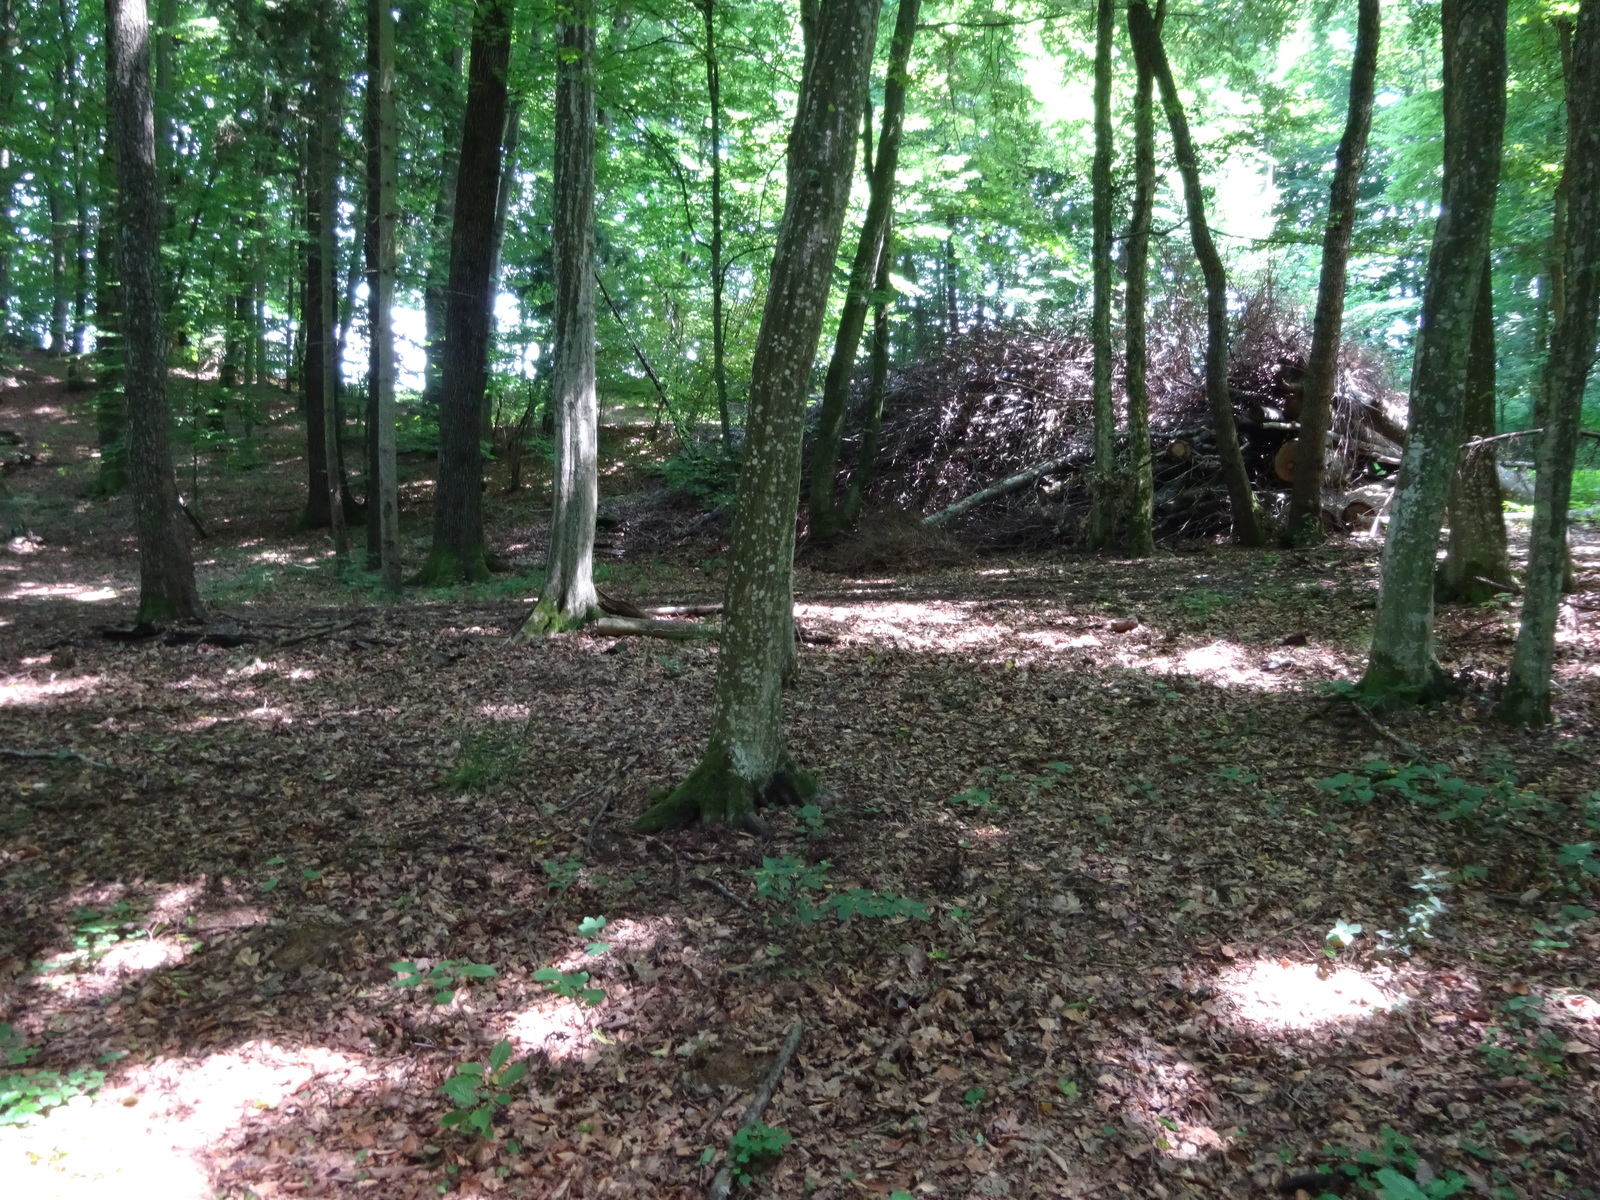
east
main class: Woodland
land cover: Broadleaved woodland
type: mountainous beech forest
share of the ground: > 75 %
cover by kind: broadleaved forest trees 100 %
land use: Forestry
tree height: > 5 m
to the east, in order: Broadleaved woodland; Paved roads, cycling and walking lanes; Broadleaved woodland; Paved roads, cycling and walking lanes; Soya; Grassland without tree/shrub cover; Common wheat; Maize; Electric lines; Maize
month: June
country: AT
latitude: 46.8497
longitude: 16.0202
